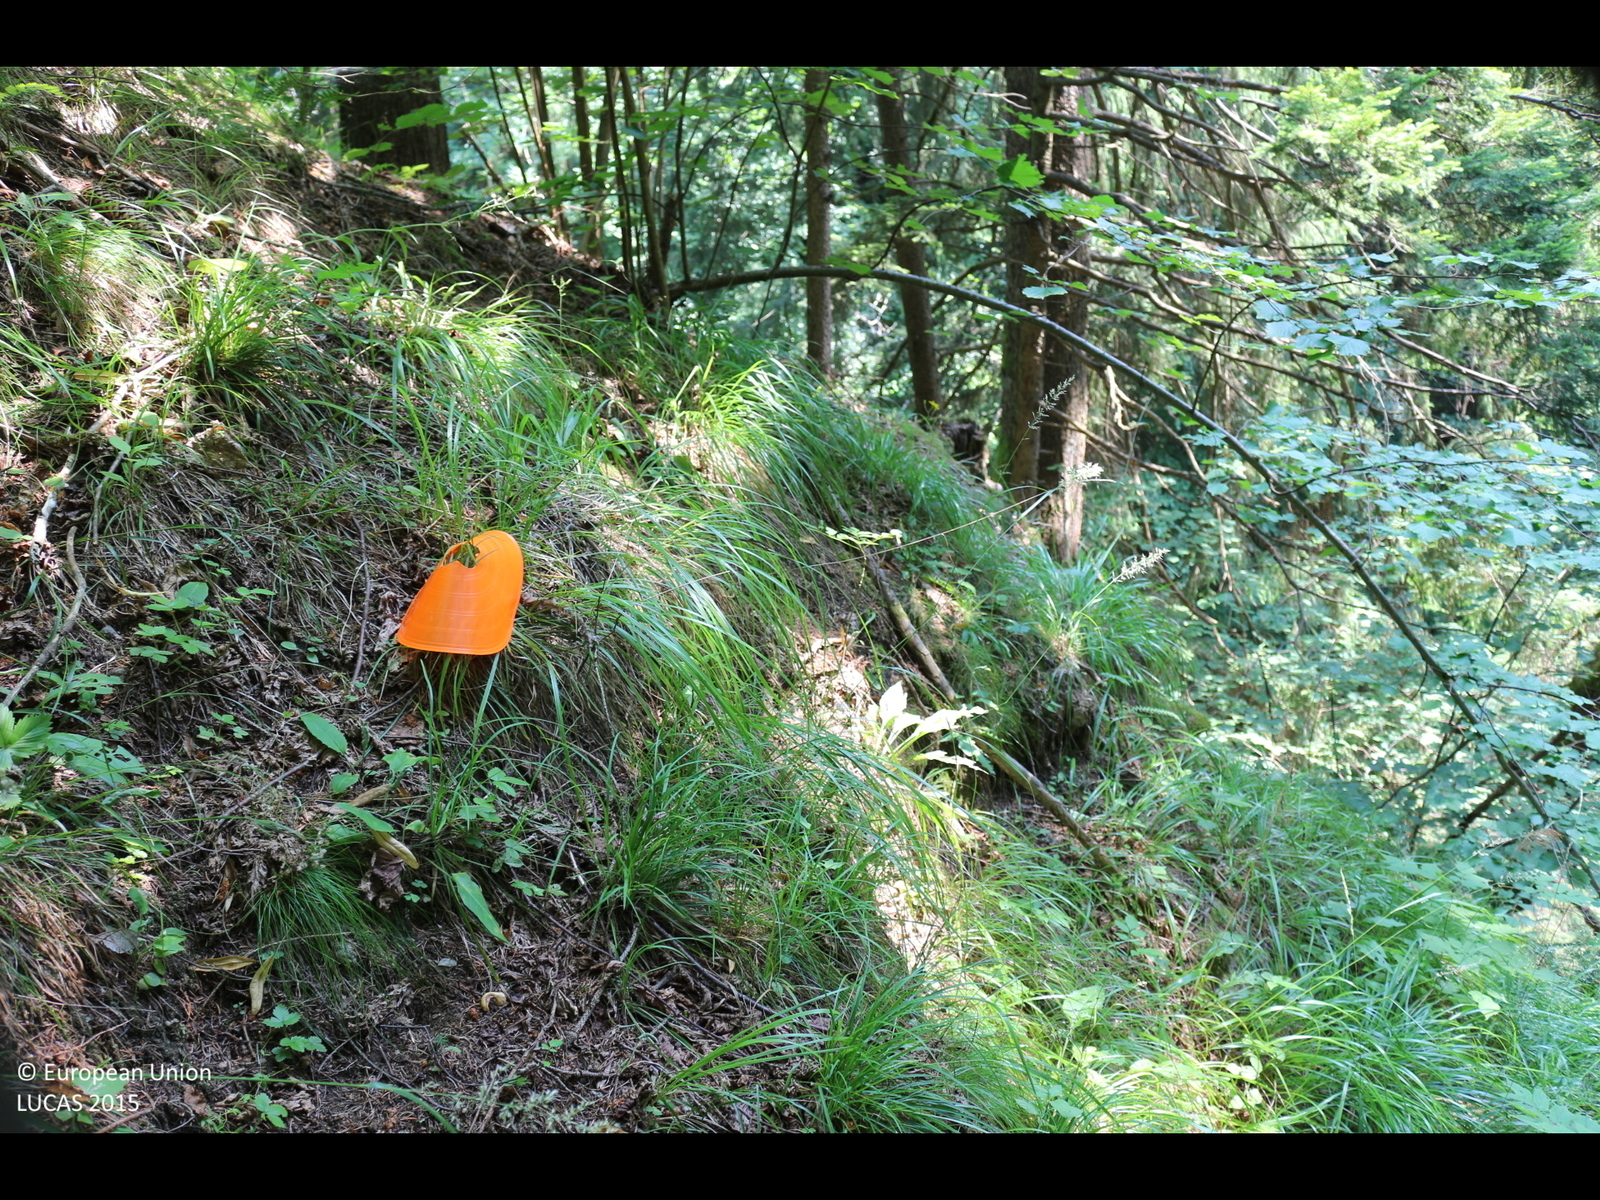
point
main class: Woodland
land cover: Spruce dominated mixed woodland
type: alpine coniferous forest
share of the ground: > 75 %
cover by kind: coniferous forest trees 60 %, broadleaved forest trees 35 %, herbaceous plants 5 %
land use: Forestry
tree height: > 5 m
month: July
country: AT
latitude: 46.8134
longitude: 13.6015
